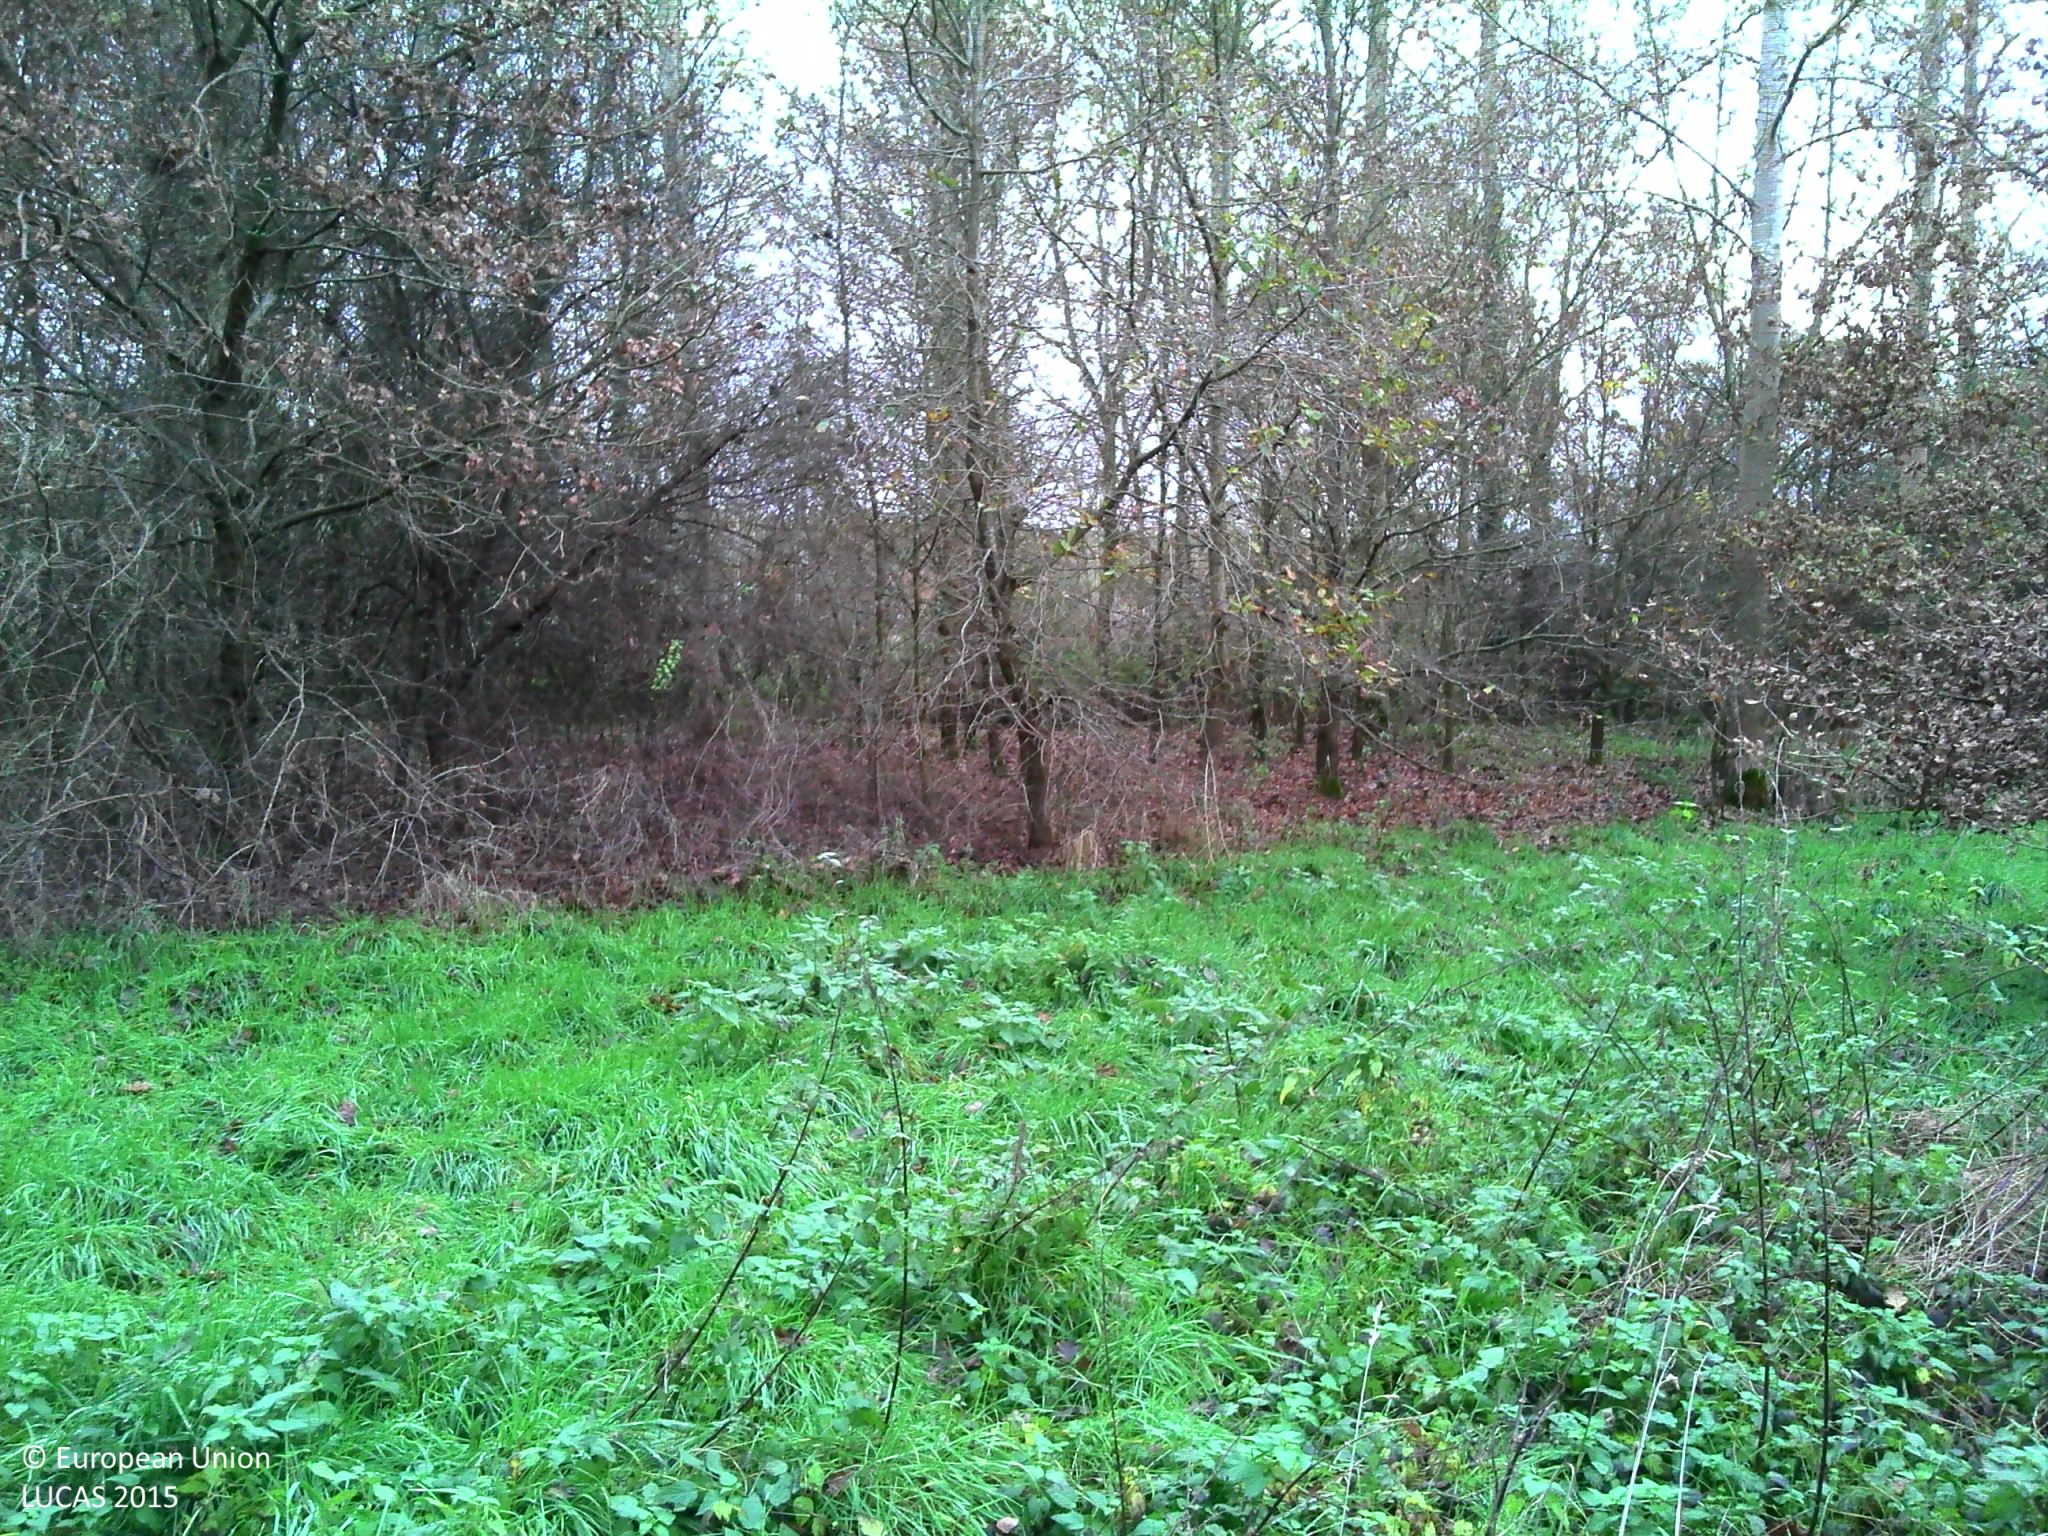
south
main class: Woodland
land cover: Broadleaved woodland
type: acidophilous oak and oak-birch forest
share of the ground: > 75 %
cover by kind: broadleaved forest trees 60 %, herbaceous plants 30 %, shrubs 10 %
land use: Forestry
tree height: > 5 m
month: November
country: FR
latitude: 46.6825
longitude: 3.2907
